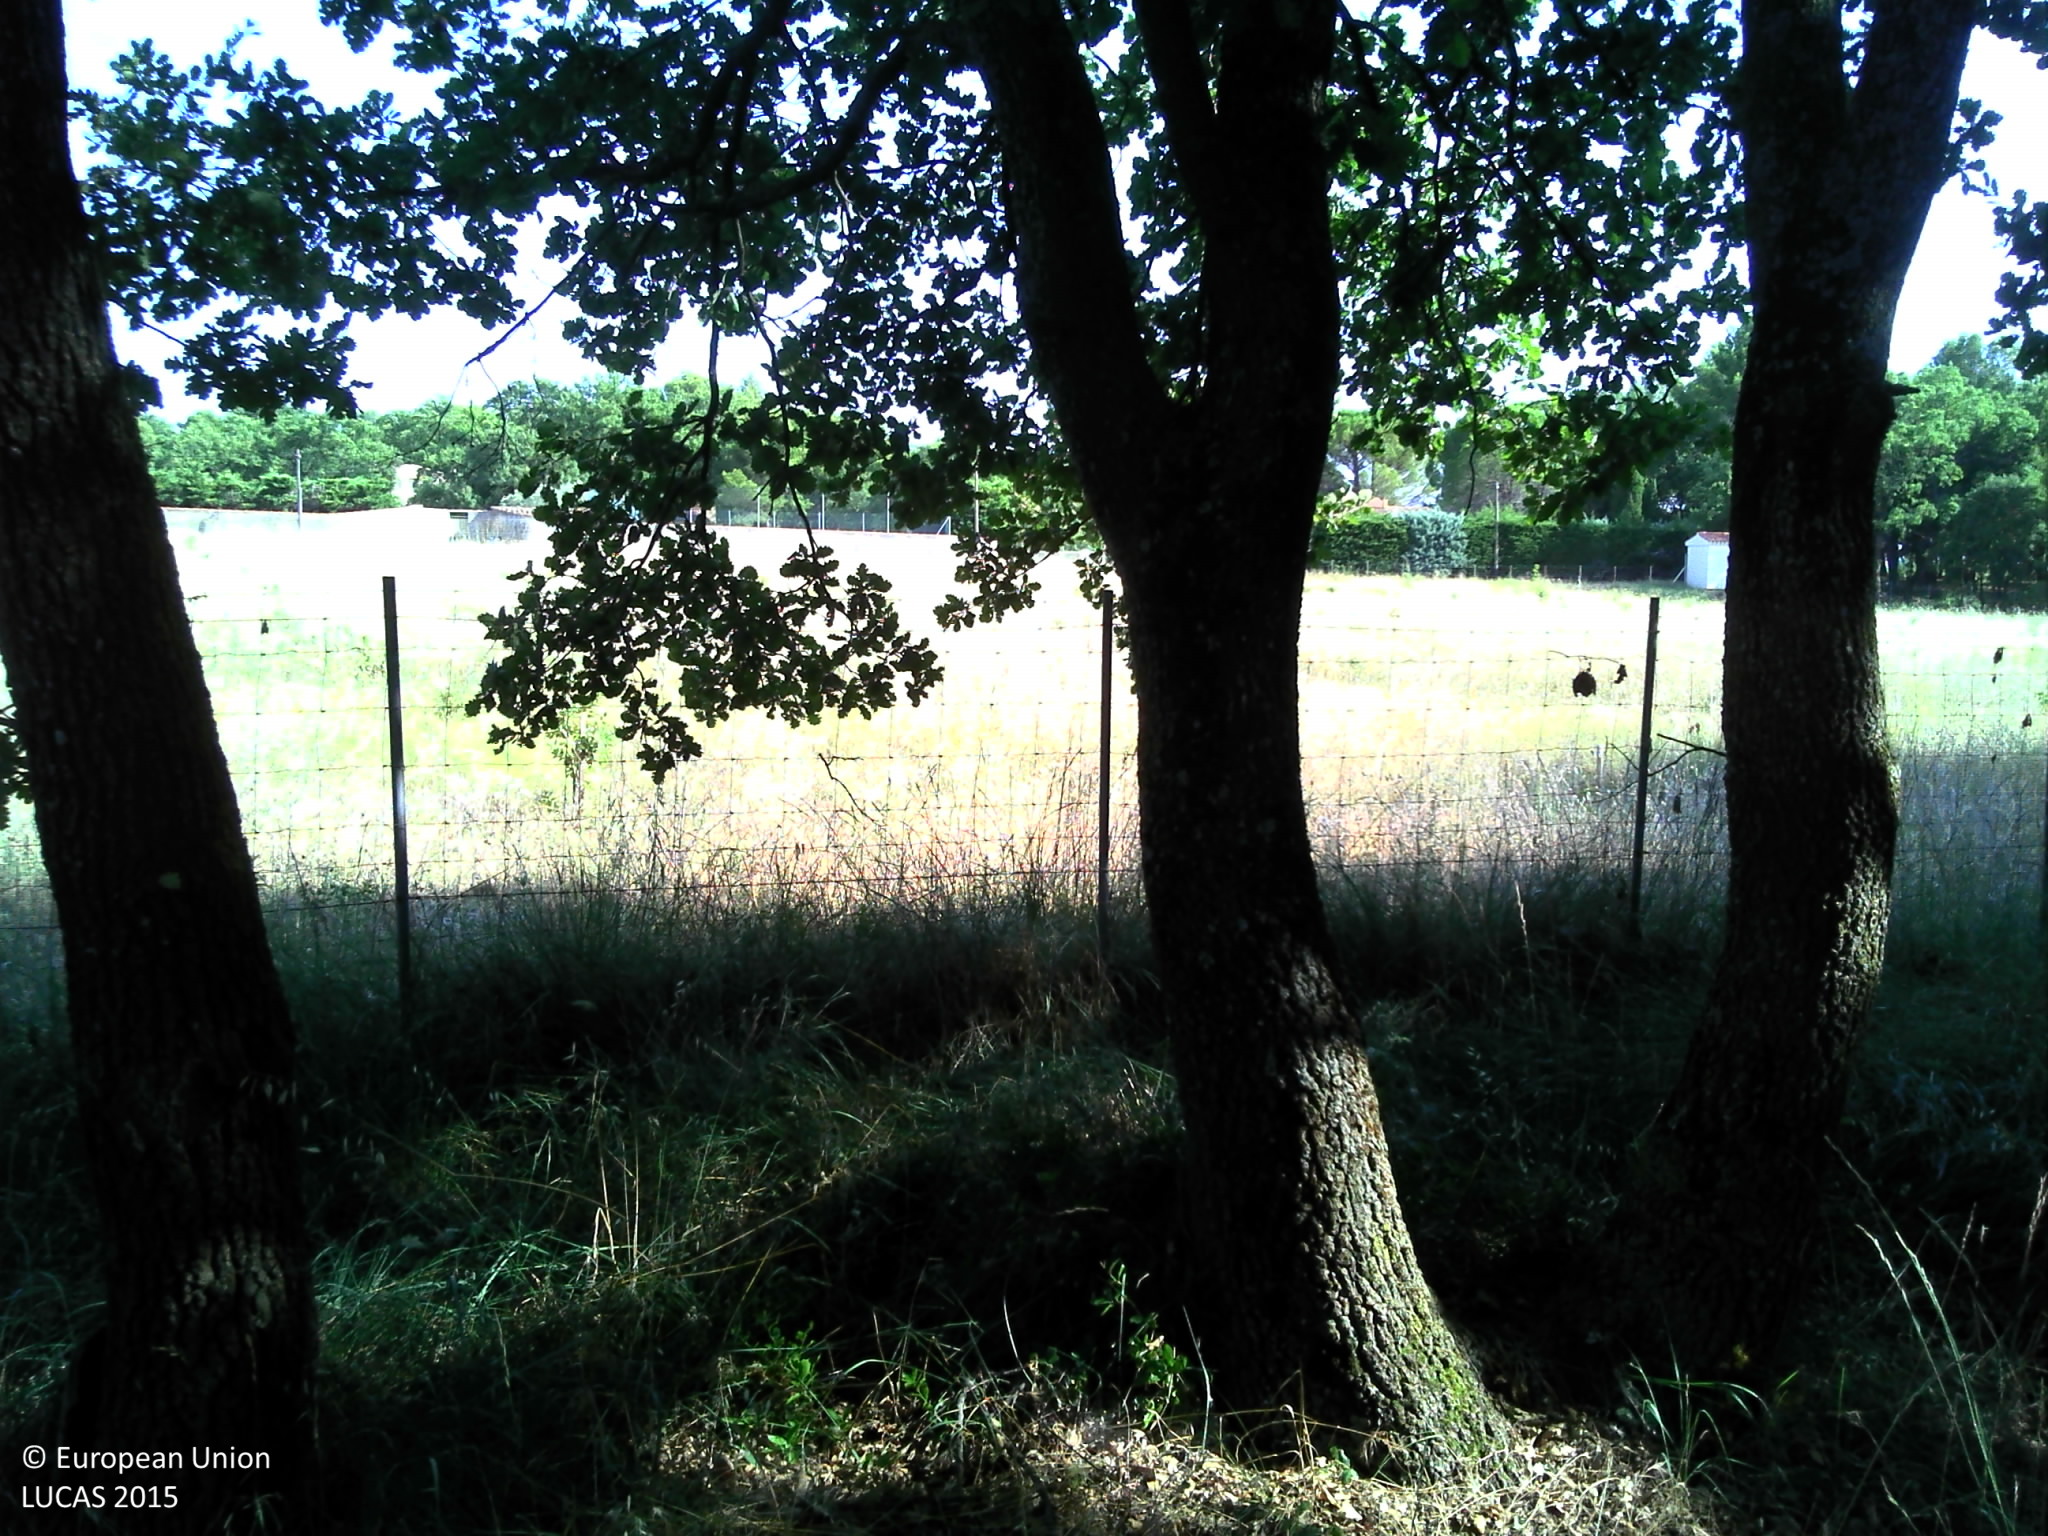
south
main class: Woodland
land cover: Broadleaved woodland
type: thermophilous deciduous forest
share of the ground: > 75 %
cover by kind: broadleaved forest trees 60 %, herbaceous plants 20 %, unconsolidated bare surface 10 %, coniferous forest trees 5 %, shrubs 5 %
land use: Forestry
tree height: > 5 m
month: October
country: FR
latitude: 44.0903
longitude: 5.0997
